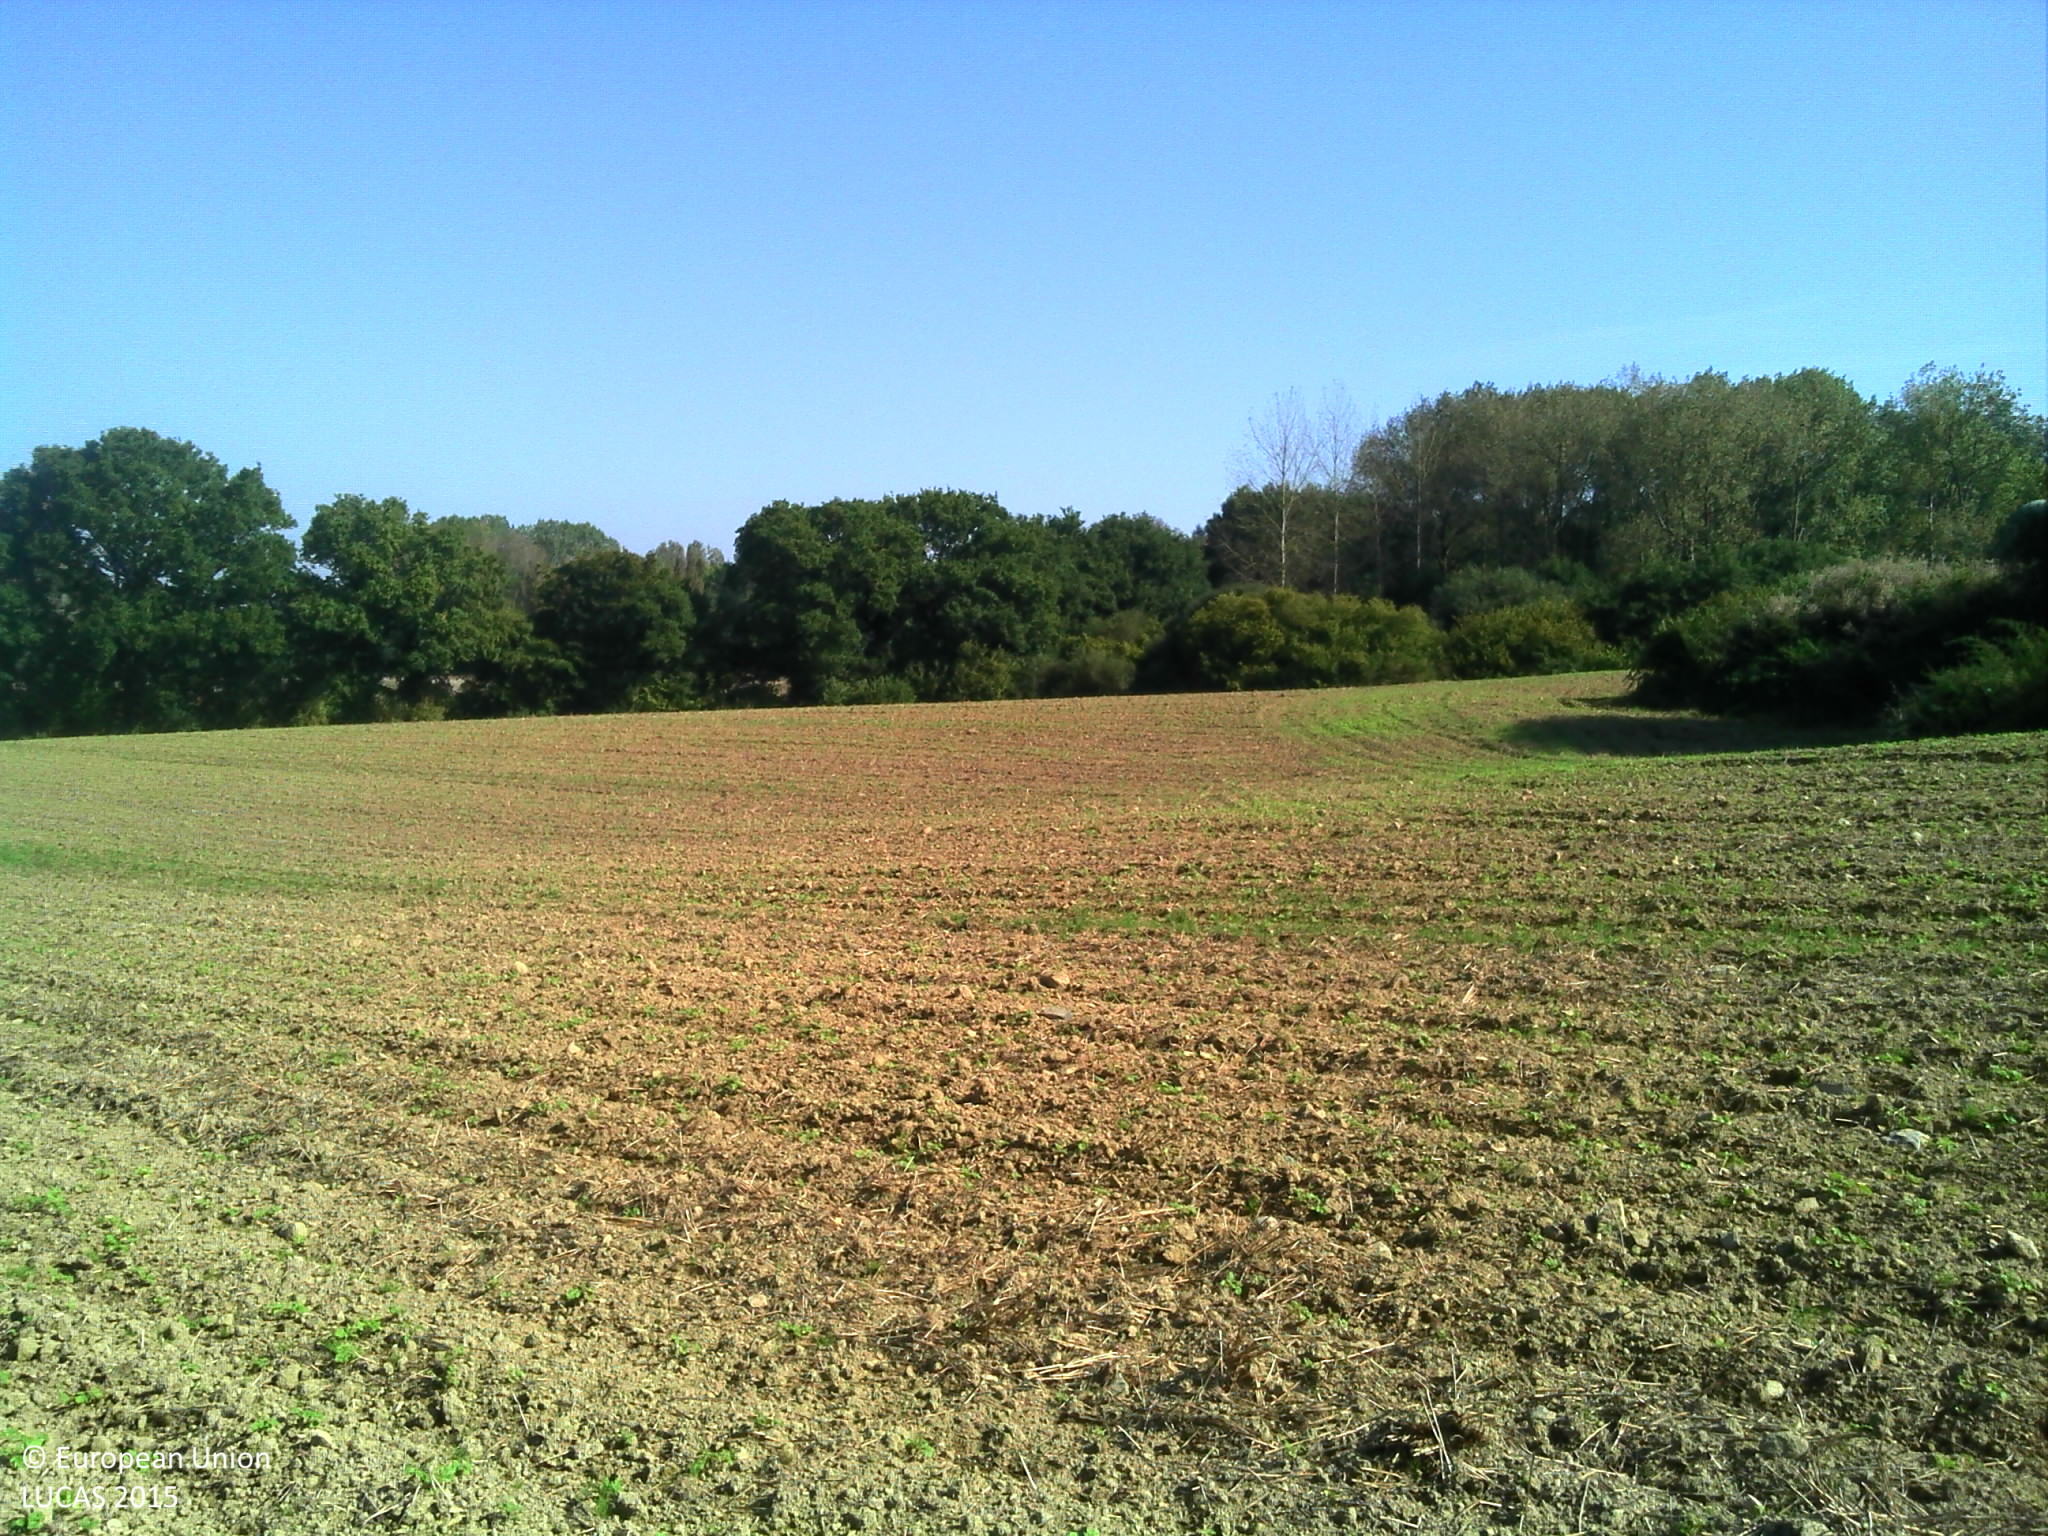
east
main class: Cropland
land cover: Rape and turnip rape
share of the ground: 10 - 25 %
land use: Agriculture (excluding fallow land and kitchen gardens)
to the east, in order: Rape and turnip rape; Broadleaved woodland; Rivers and streams; Broadleaved woodland; Potatoes
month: October
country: FR
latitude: 48.4560
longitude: -3.1206
